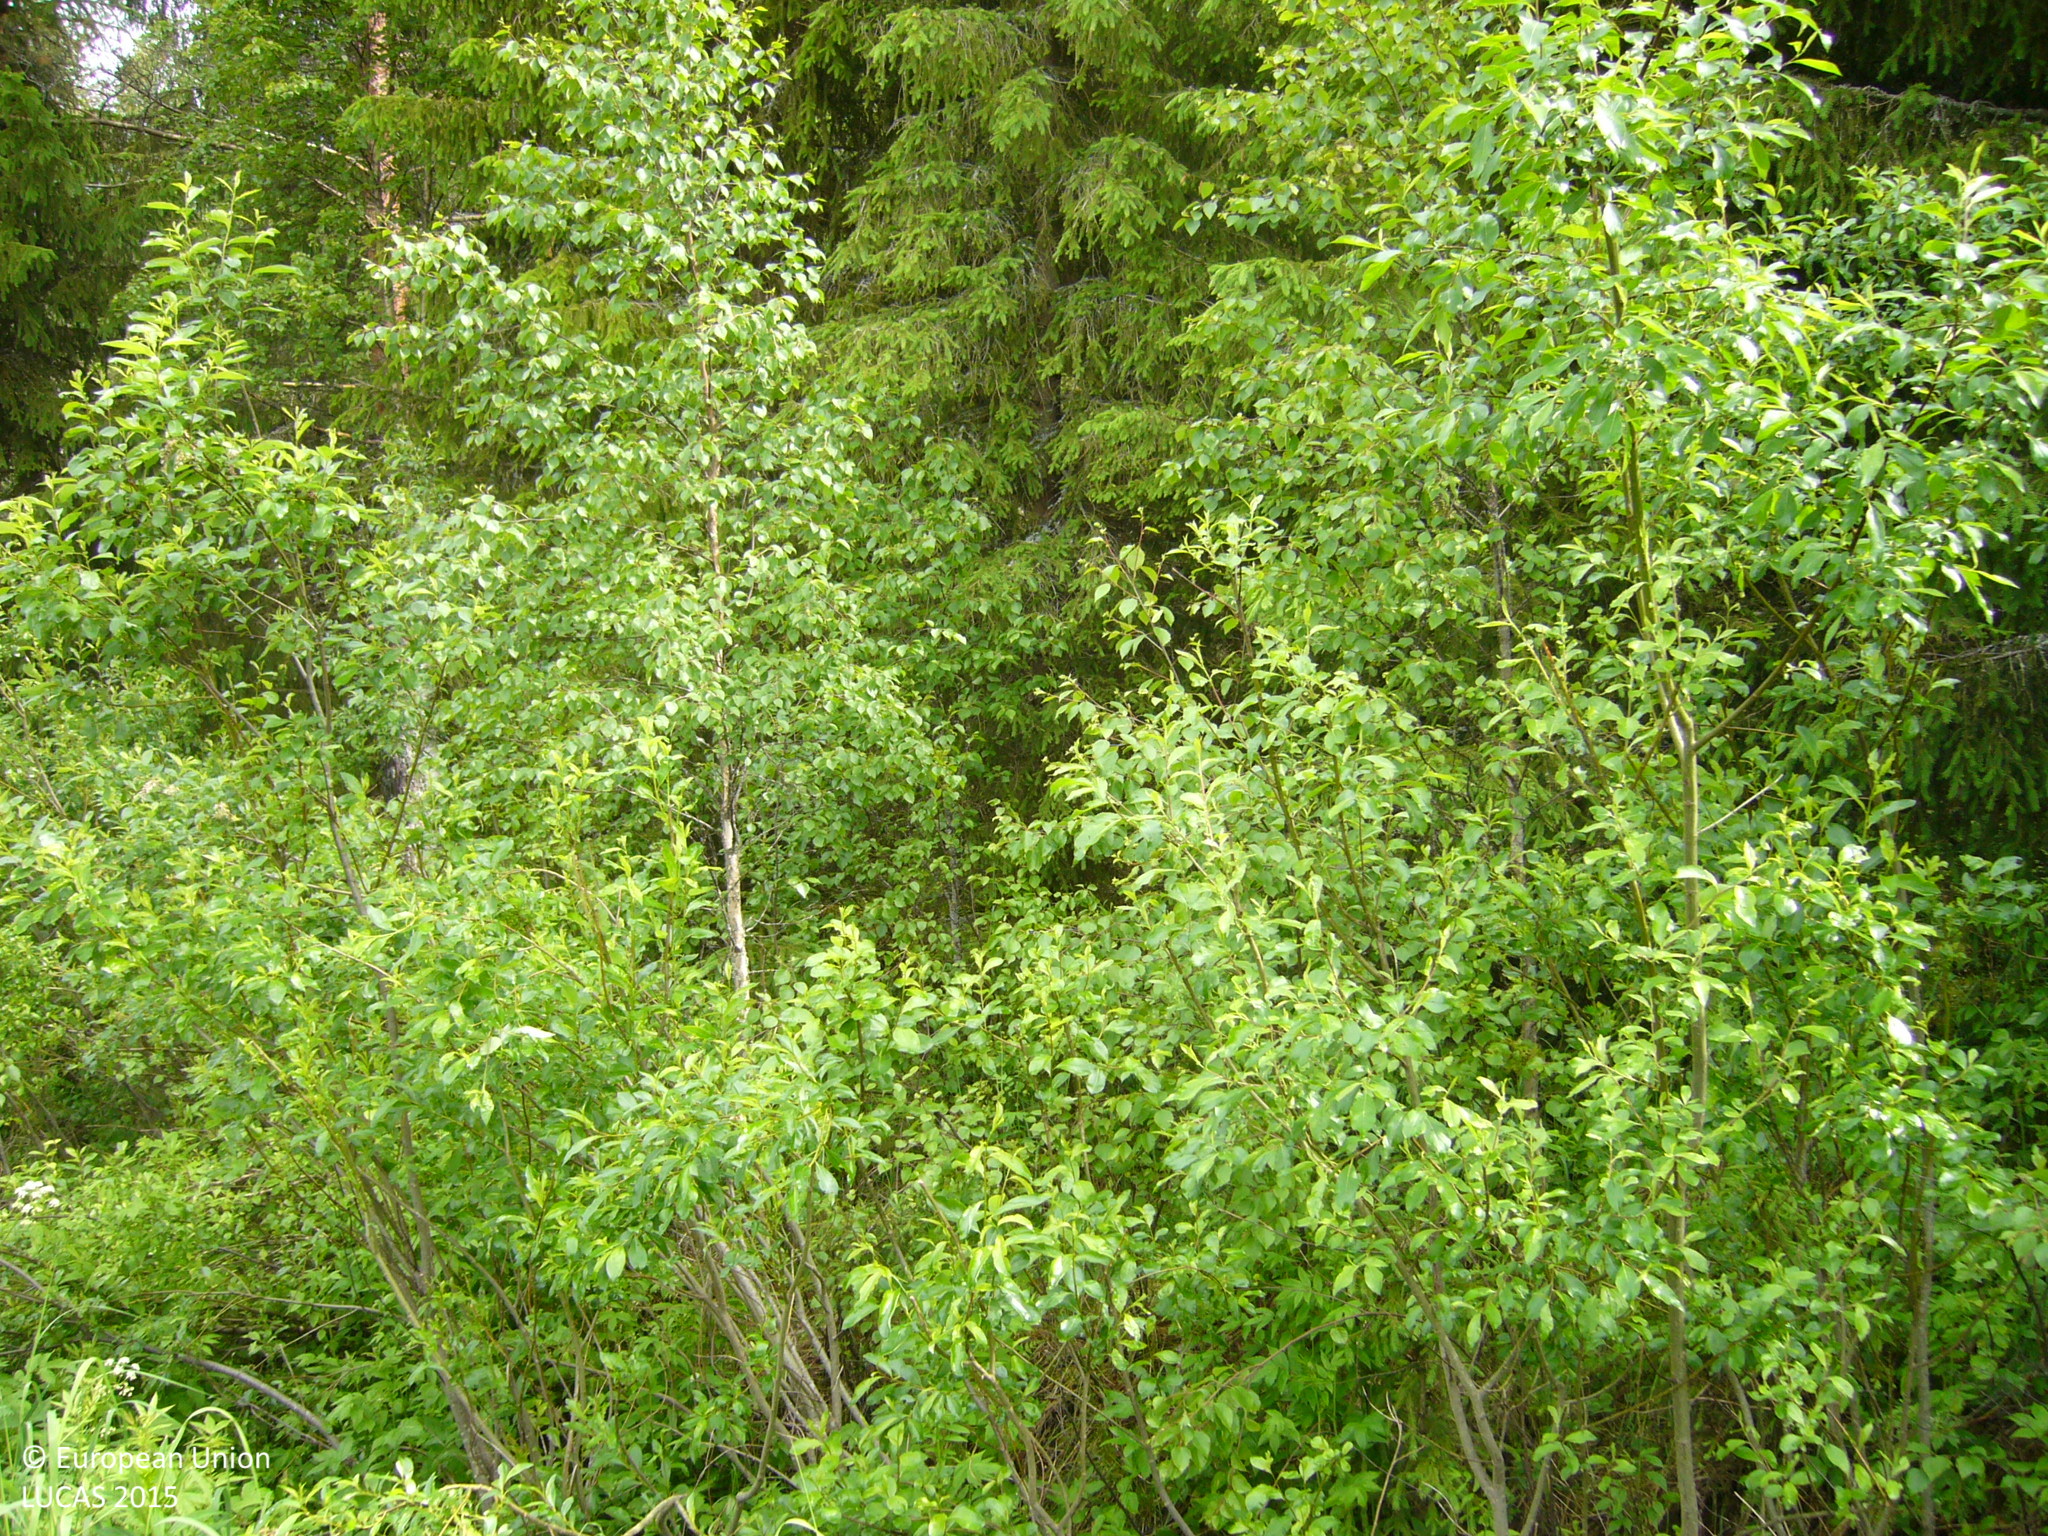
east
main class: Woodland
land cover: Spruce dominated mixed woodland
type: boreal forest
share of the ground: 50 - 75 %
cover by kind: coniferous forest trees 40 %, herbaceous plants 35 %, broadleaved forest trees 25 %
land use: Forestry
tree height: > 5 m
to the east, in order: Spruce dominated mixed woodland; Spontaneously vegetated surfaces; Ditches and canals; Spruce dominated mixed woodland; Ditches and canals; Spruce dominated mixed woodland; Spontaneously vegetated surfaces; Tracks; Grass margins; Ditches and canals; Spruce dominated mixed woodland; Ditches and canals; Spruce dominated mixed woodland; Ditches and canals; Spruce dominated mixed woodland
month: June
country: FI
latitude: 63.7891
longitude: 26.4581
